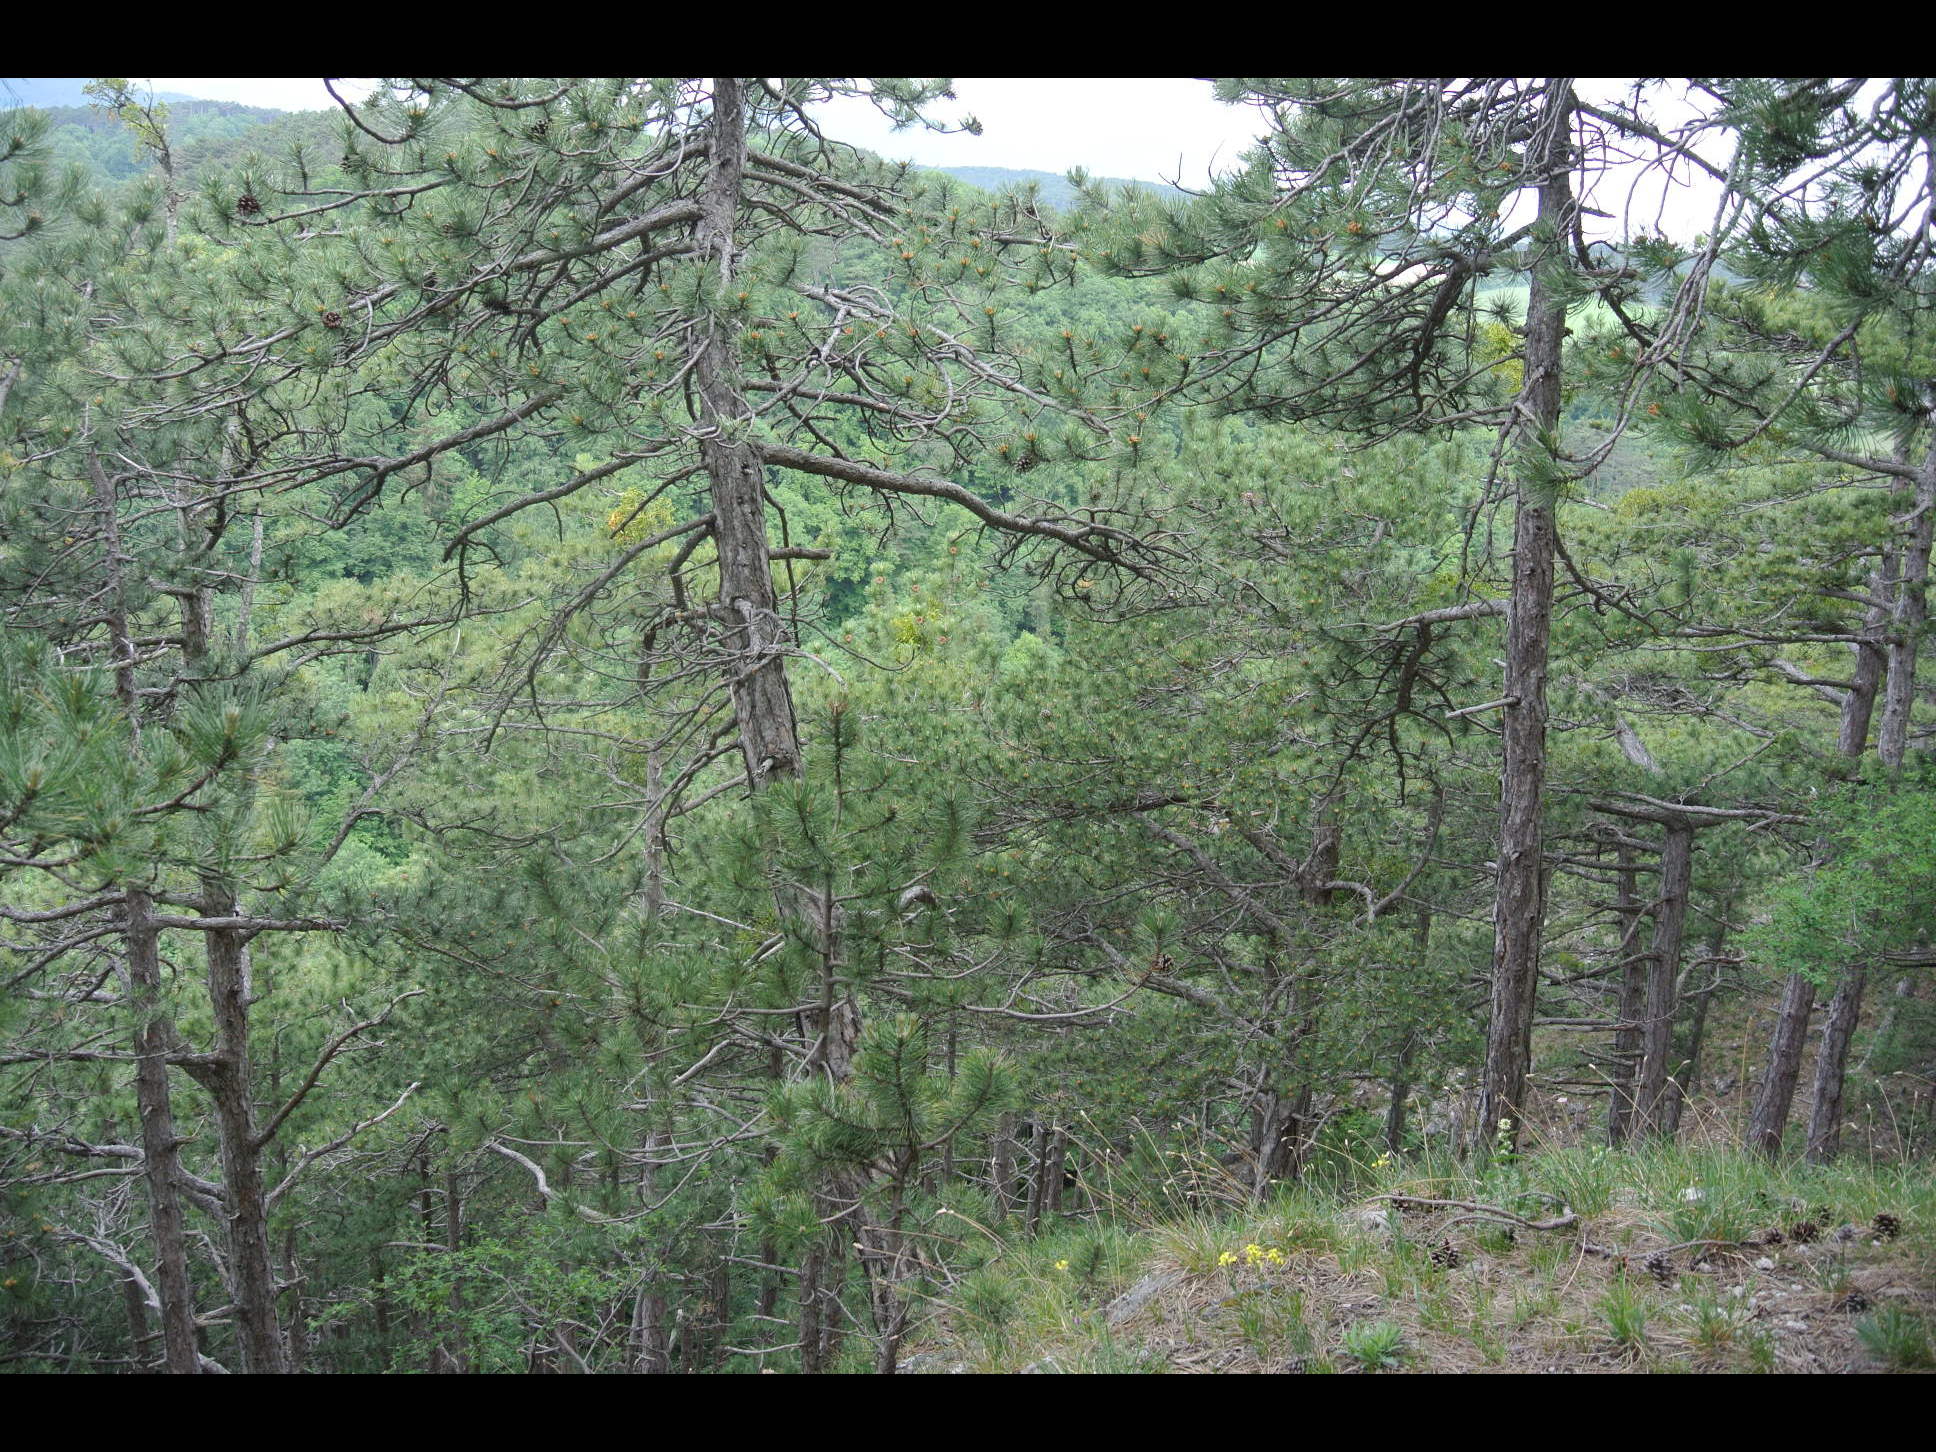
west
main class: Woodland
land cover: Pine dominated coniferous woodland
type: alpine coniferous forest
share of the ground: > 75 %
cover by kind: coniferous forest trees 85 %, herbaceous plants 10 %, unconsolidated bare surface 5 %
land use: Forestry
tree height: > 5 m
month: May
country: AT
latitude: 47.8540
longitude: 16.1380
